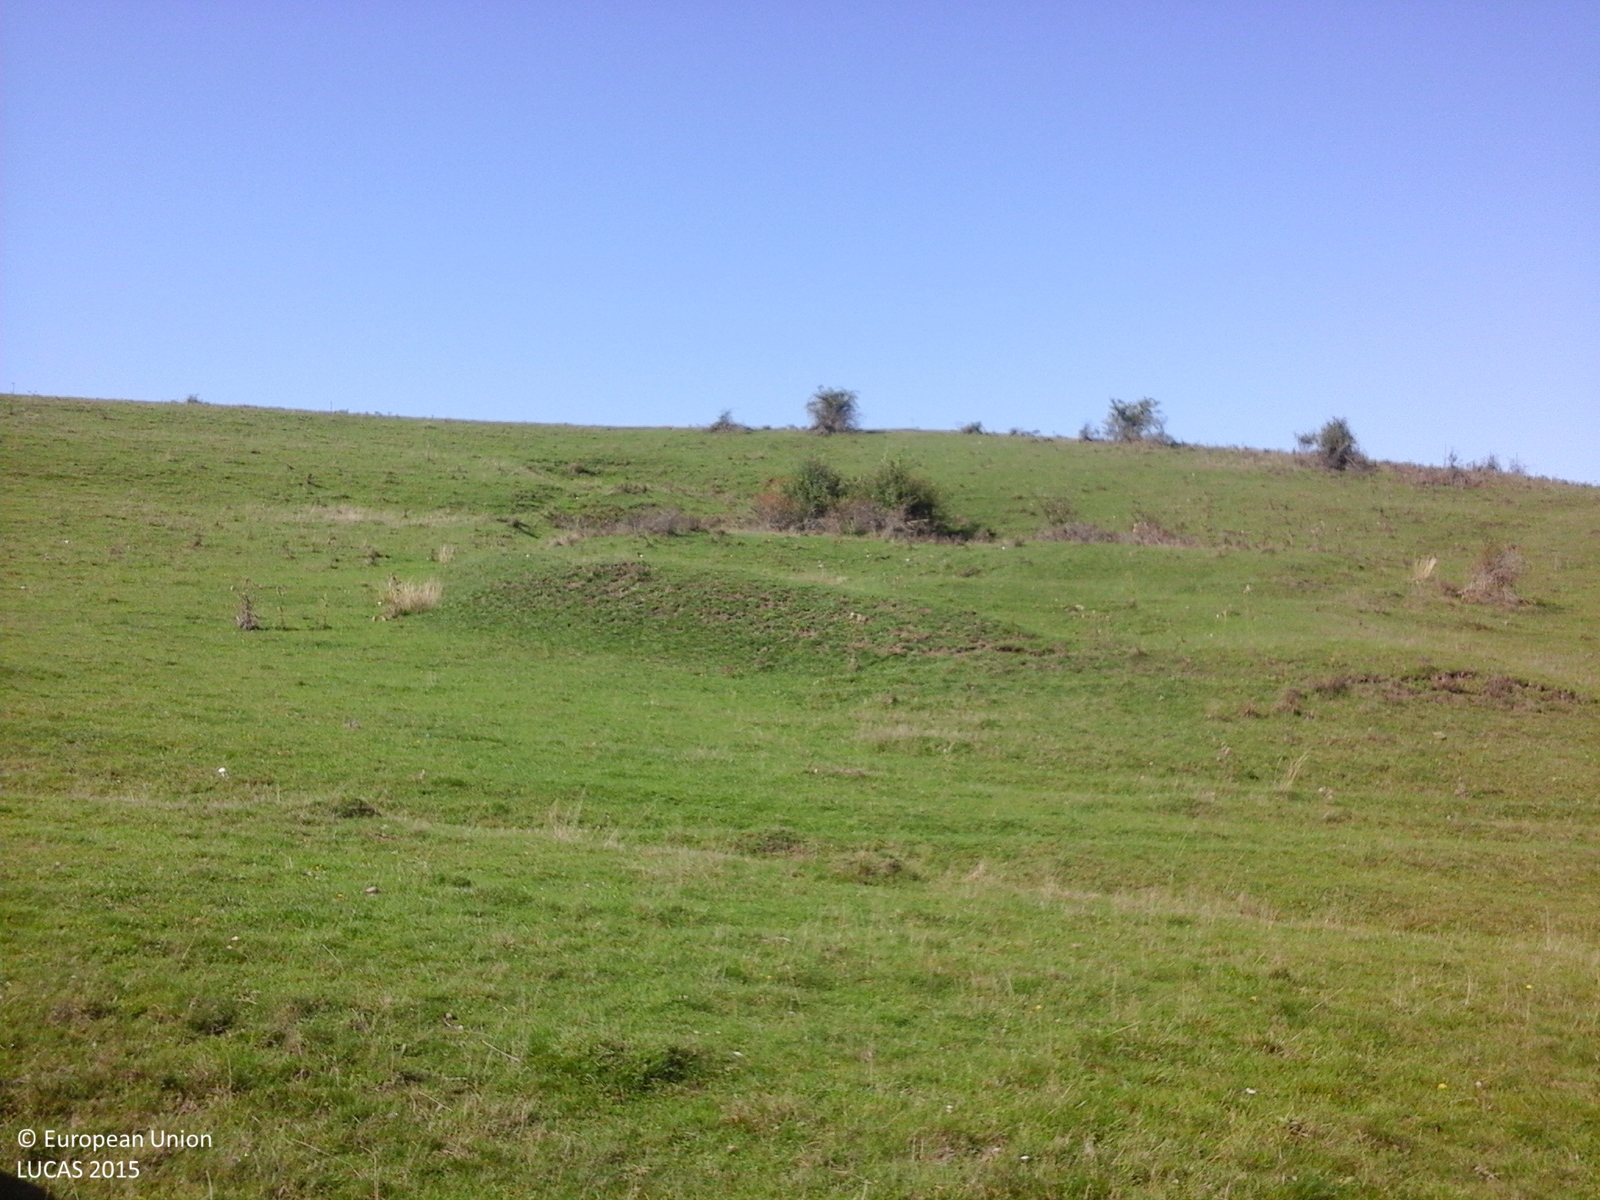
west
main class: Grassland
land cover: Grassland without tree/shrub cover
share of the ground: > 75 %
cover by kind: herbaceous plants 100 %
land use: Agriculture (excluding fallow land and kitchen gardens)
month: October
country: RO
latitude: 46.6115
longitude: 23.5838
